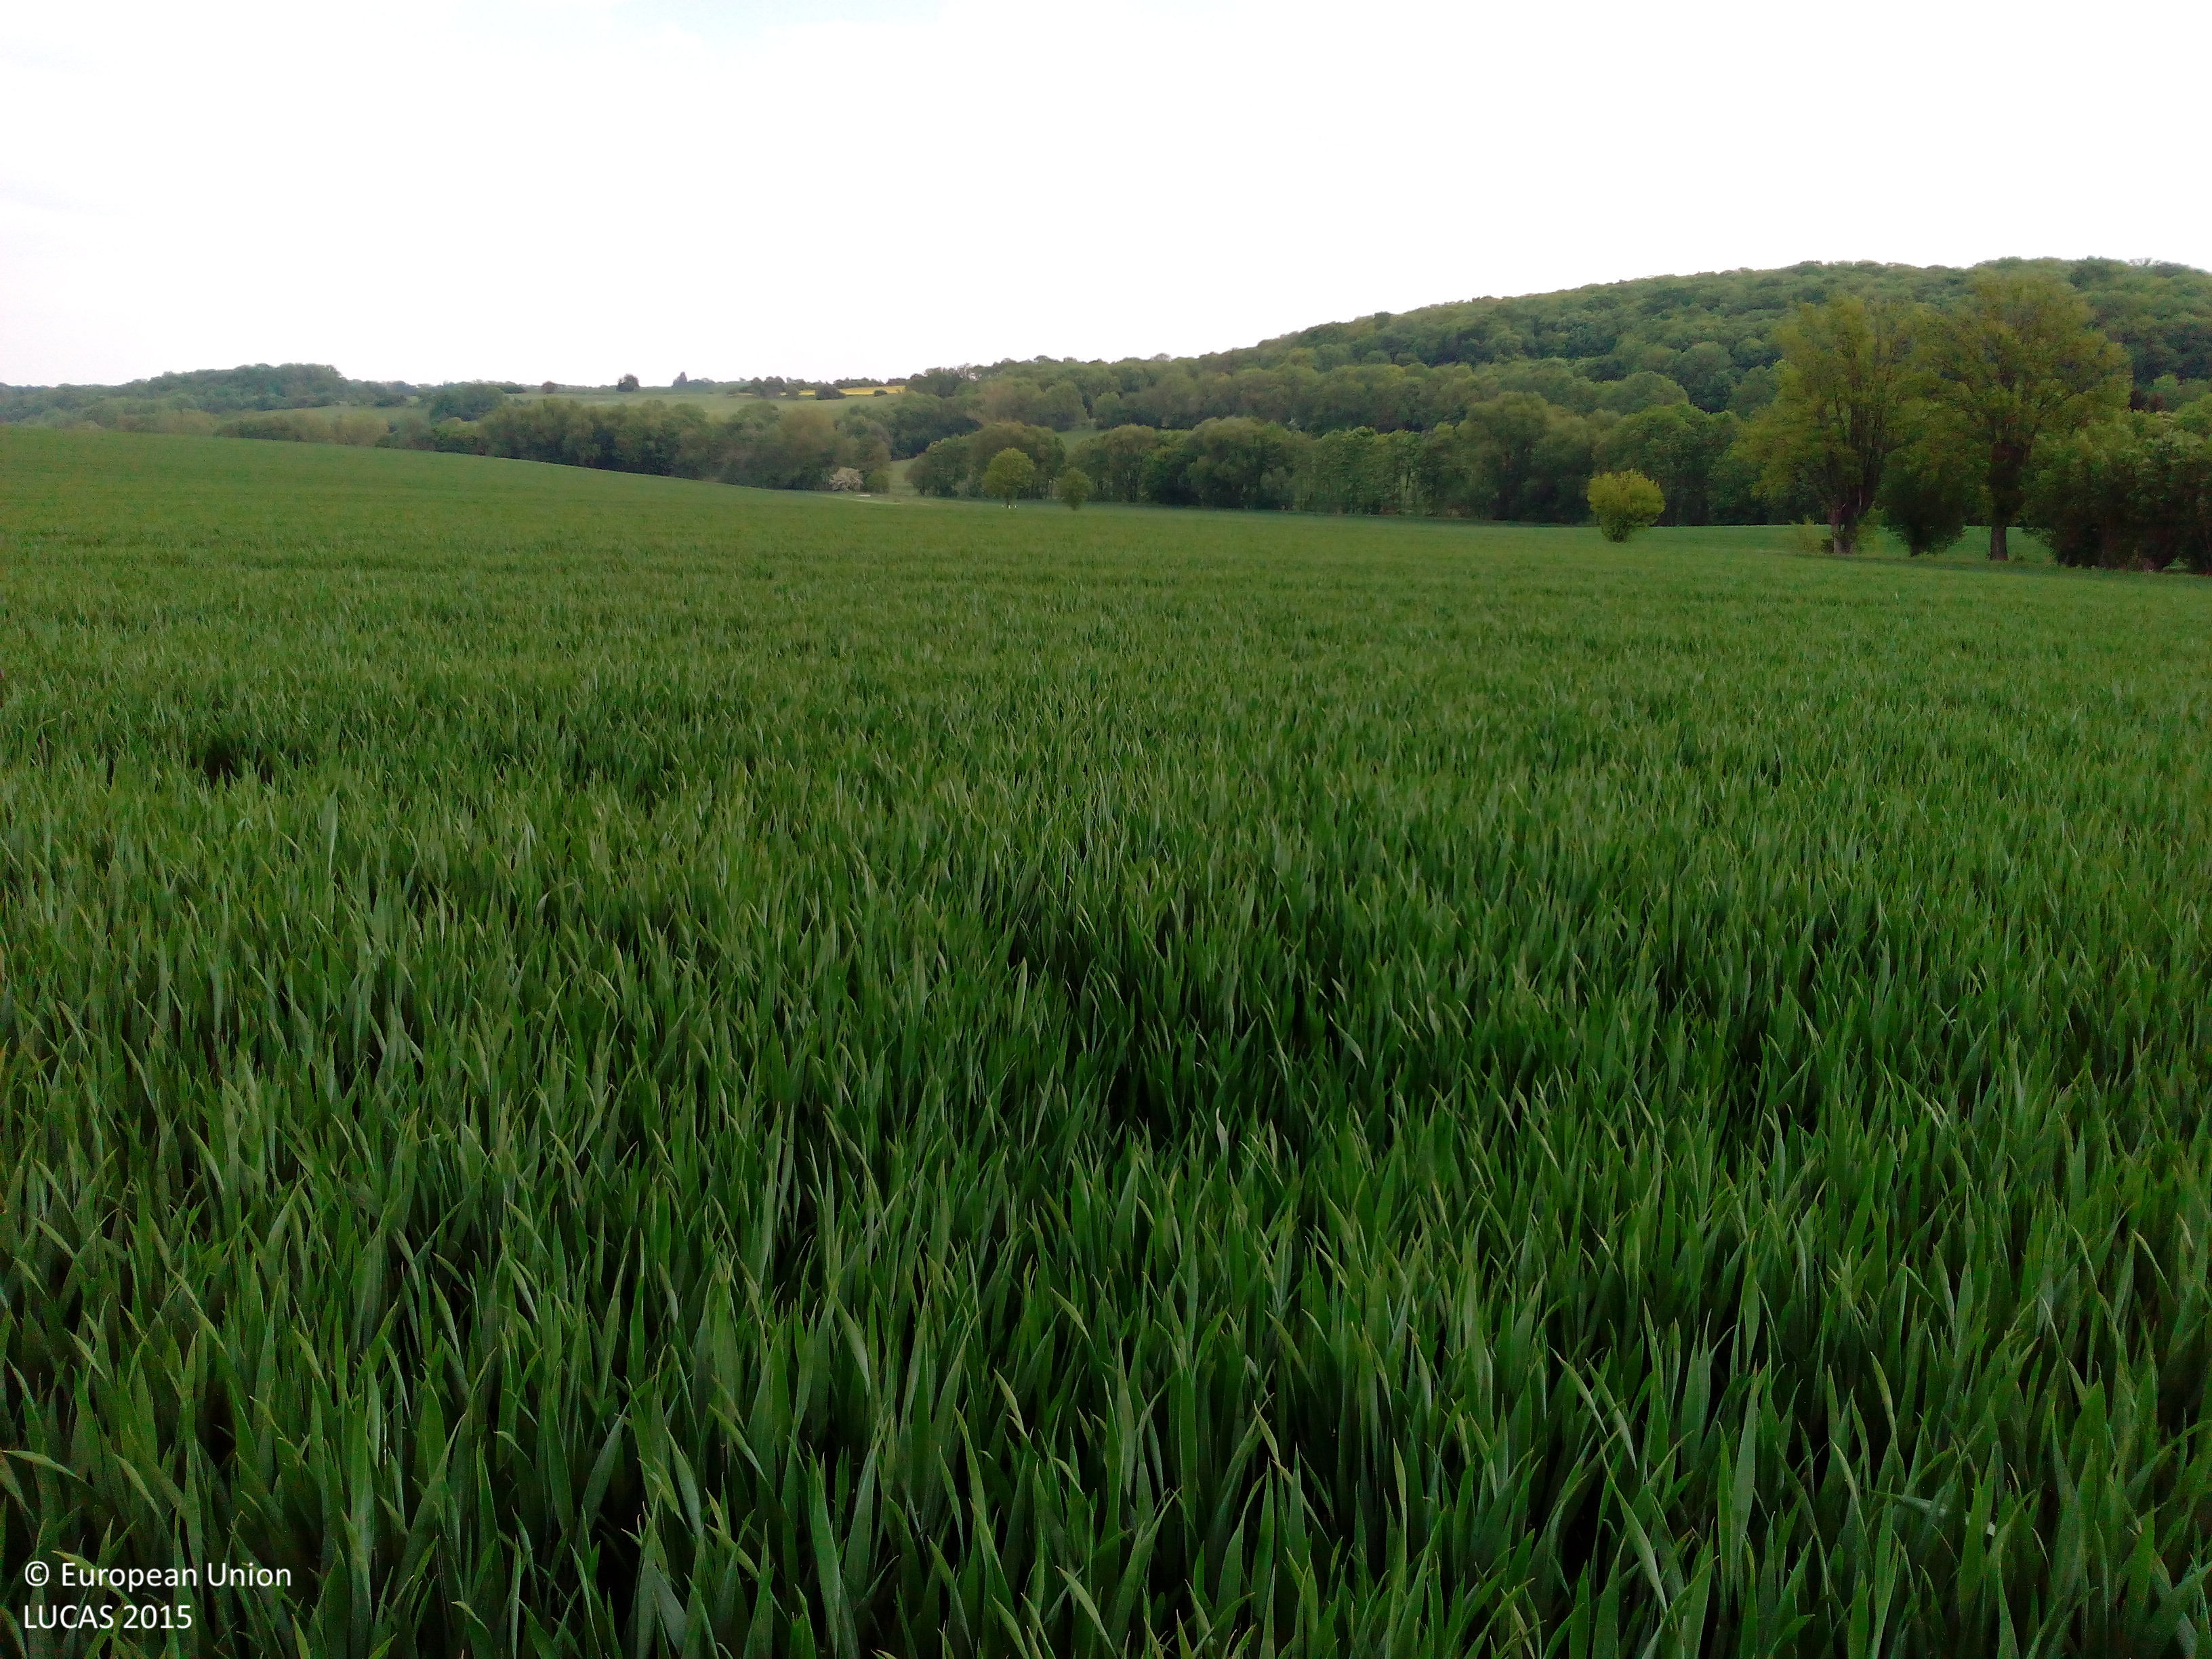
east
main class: Cropland
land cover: Common wheat
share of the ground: > 75 %
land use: Agriculture (excluding fallow land and kitchen gardens)
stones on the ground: < 10 %
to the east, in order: Common wheat; Grass margins; Ditches and canals; Grass margins; Paved roads, cycling and walking lanes; Grassland without tree/shrub cover; Ditches and canals; Common wheat
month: May
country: DE
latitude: 50.9840
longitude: 11.4669
